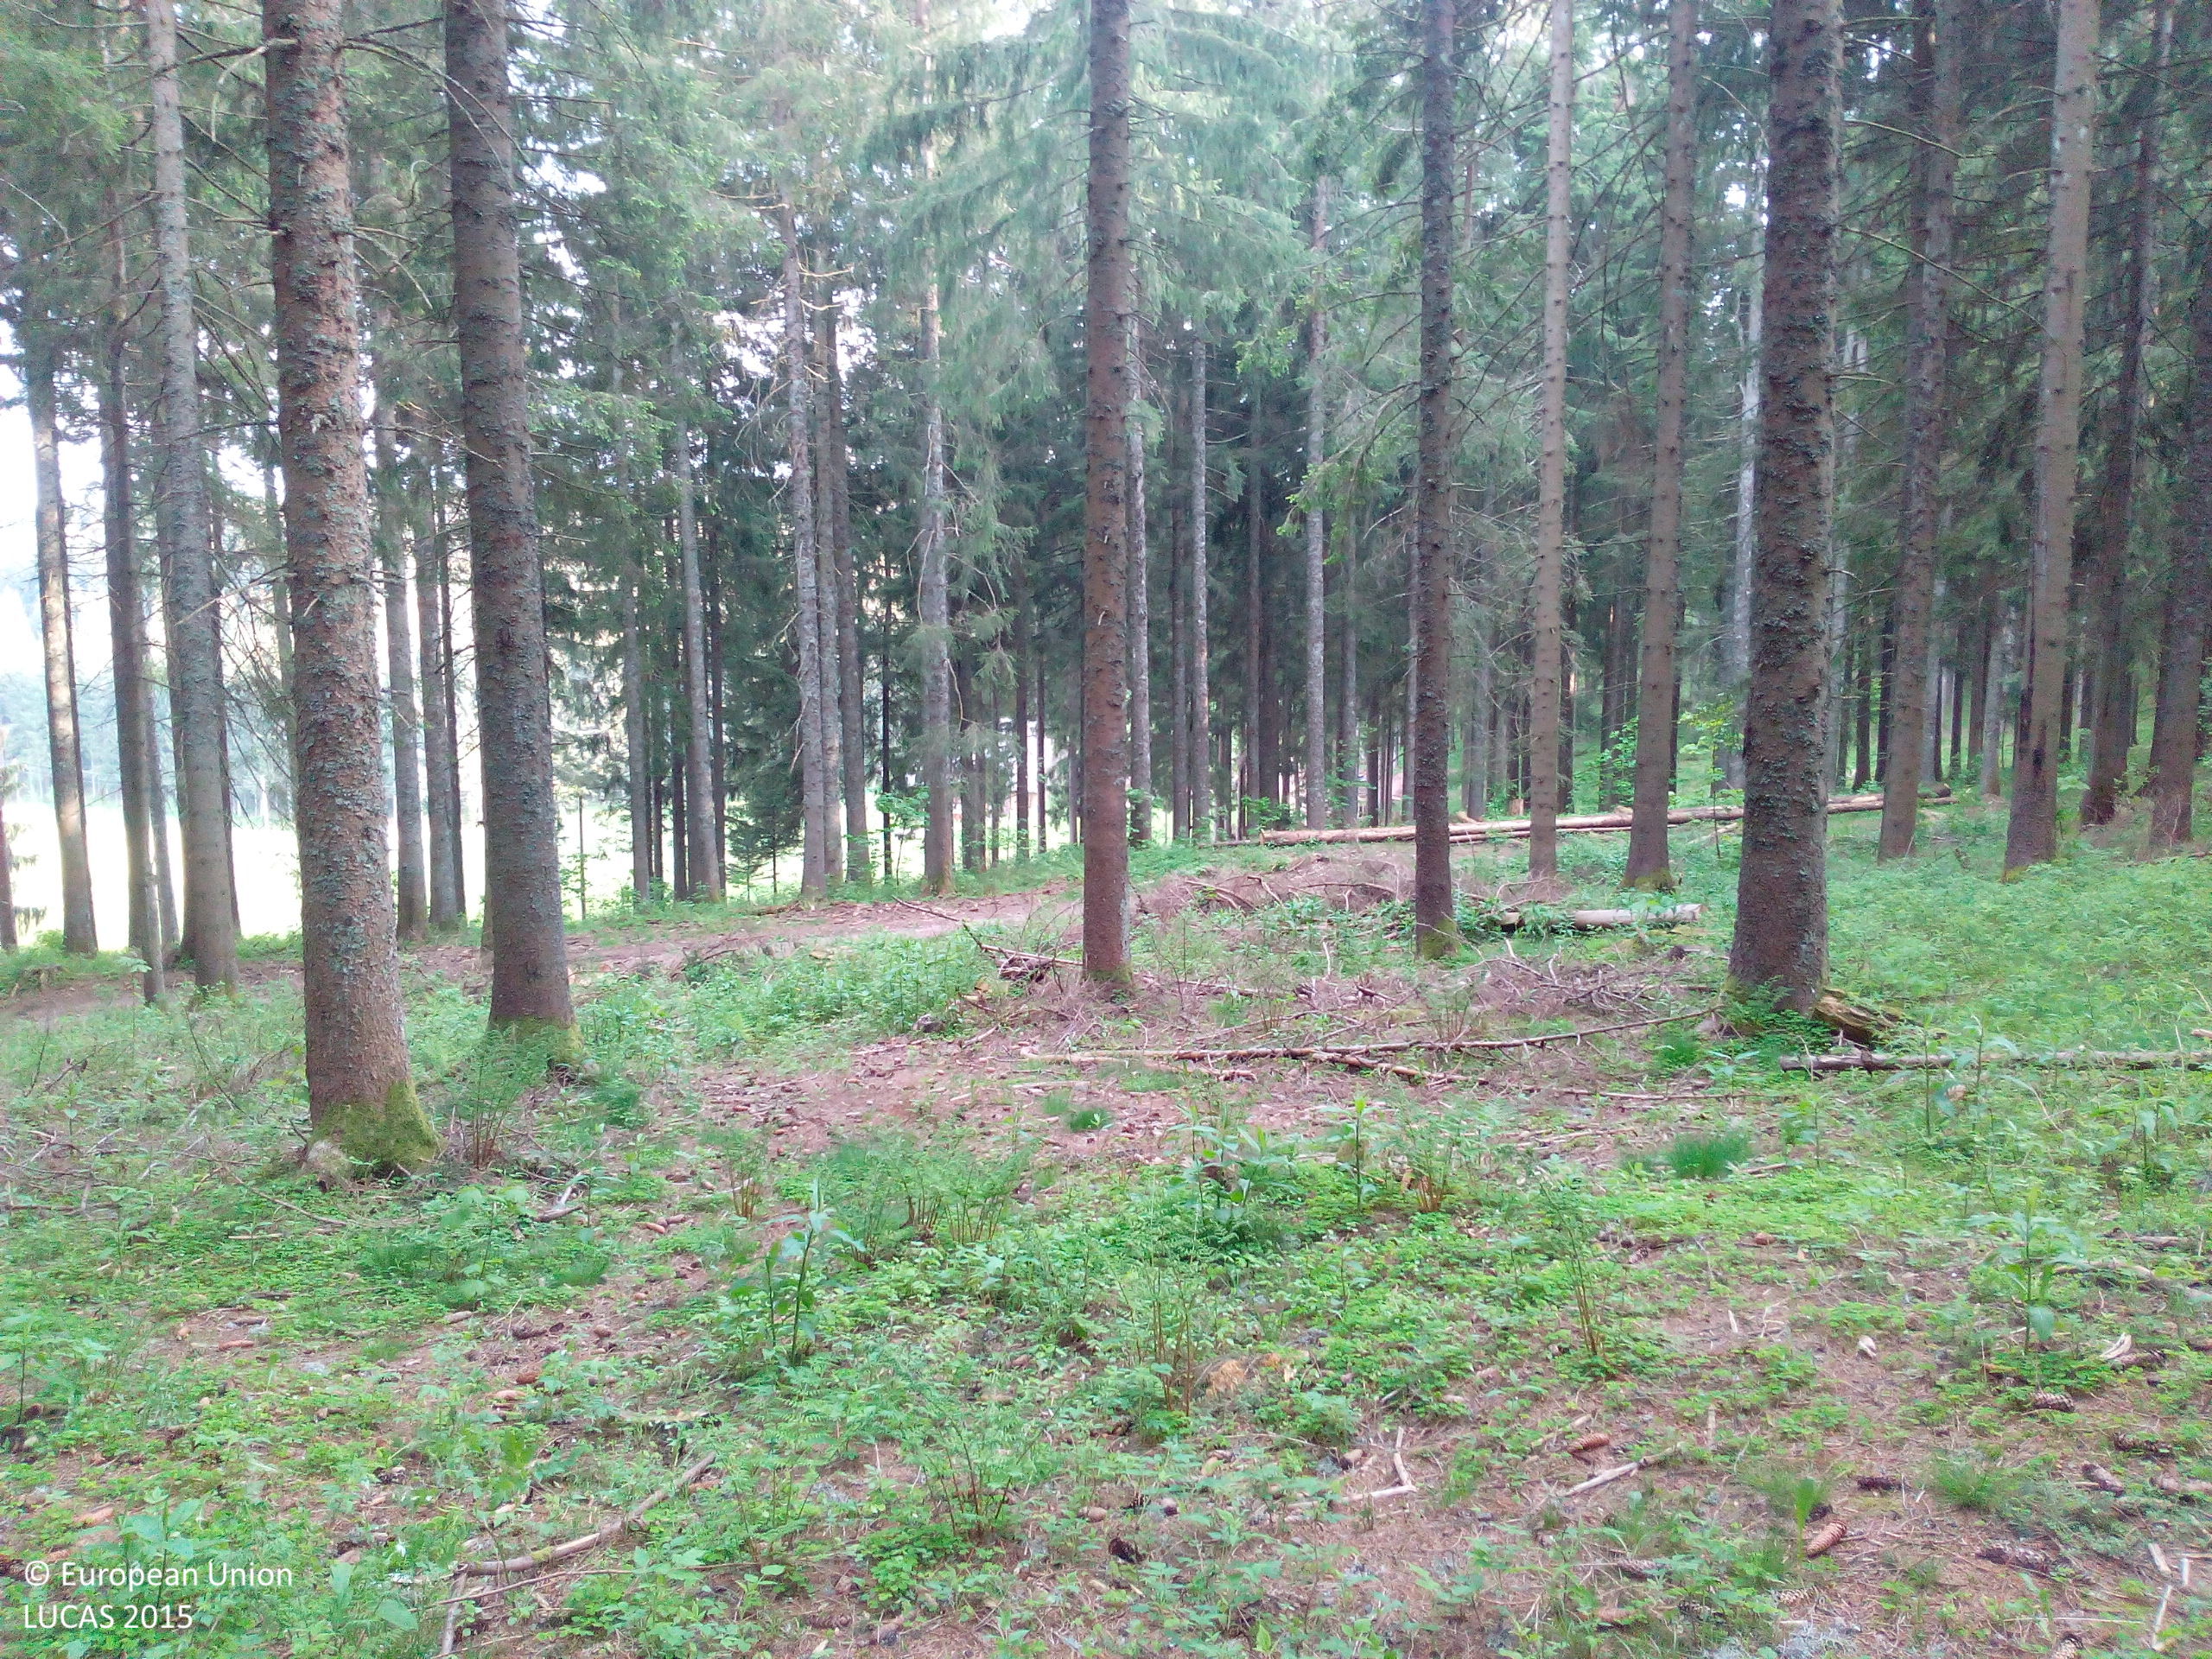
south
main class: Woodland
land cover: Spruce dominated coniferous woodland
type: hemiboreal forest and nemoral coniferous forest and mixed broadleaved-coniferous forest
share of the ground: > 75 %
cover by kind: coniferous forest trees 95 %, herbaceous plants 5 %
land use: Forestry
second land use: Amenities, museums, leisure
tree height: > 5 m
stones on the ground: < 10 %
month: May
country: DE
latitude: 48.1007
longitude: 8.1881
